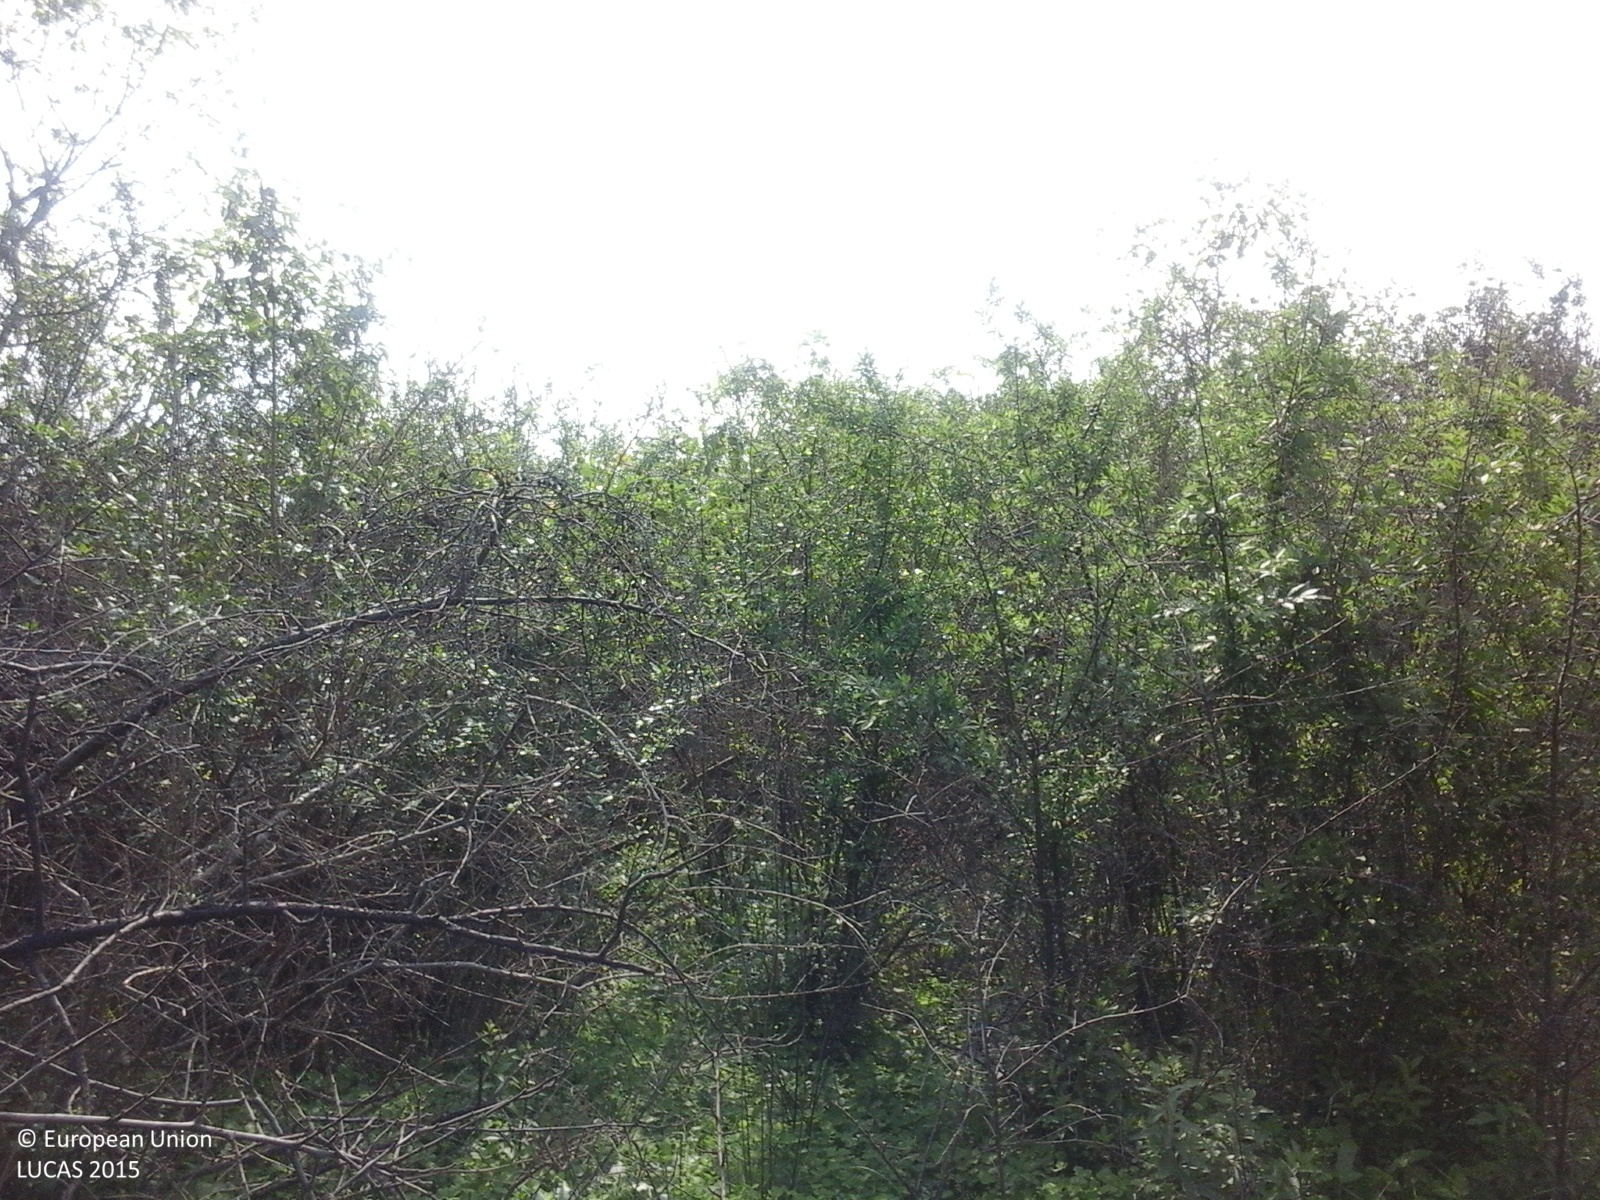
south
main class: Shrubland
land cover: Shrubland with sparse tree cover
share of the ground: > 75 %
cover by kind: shrubs 95 %, broadleaved forest trees 5 %
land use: Semi-natural and natural areas not in use
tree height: > 5 m
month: September
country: RO
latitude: 44.9780
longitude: 23.2283
